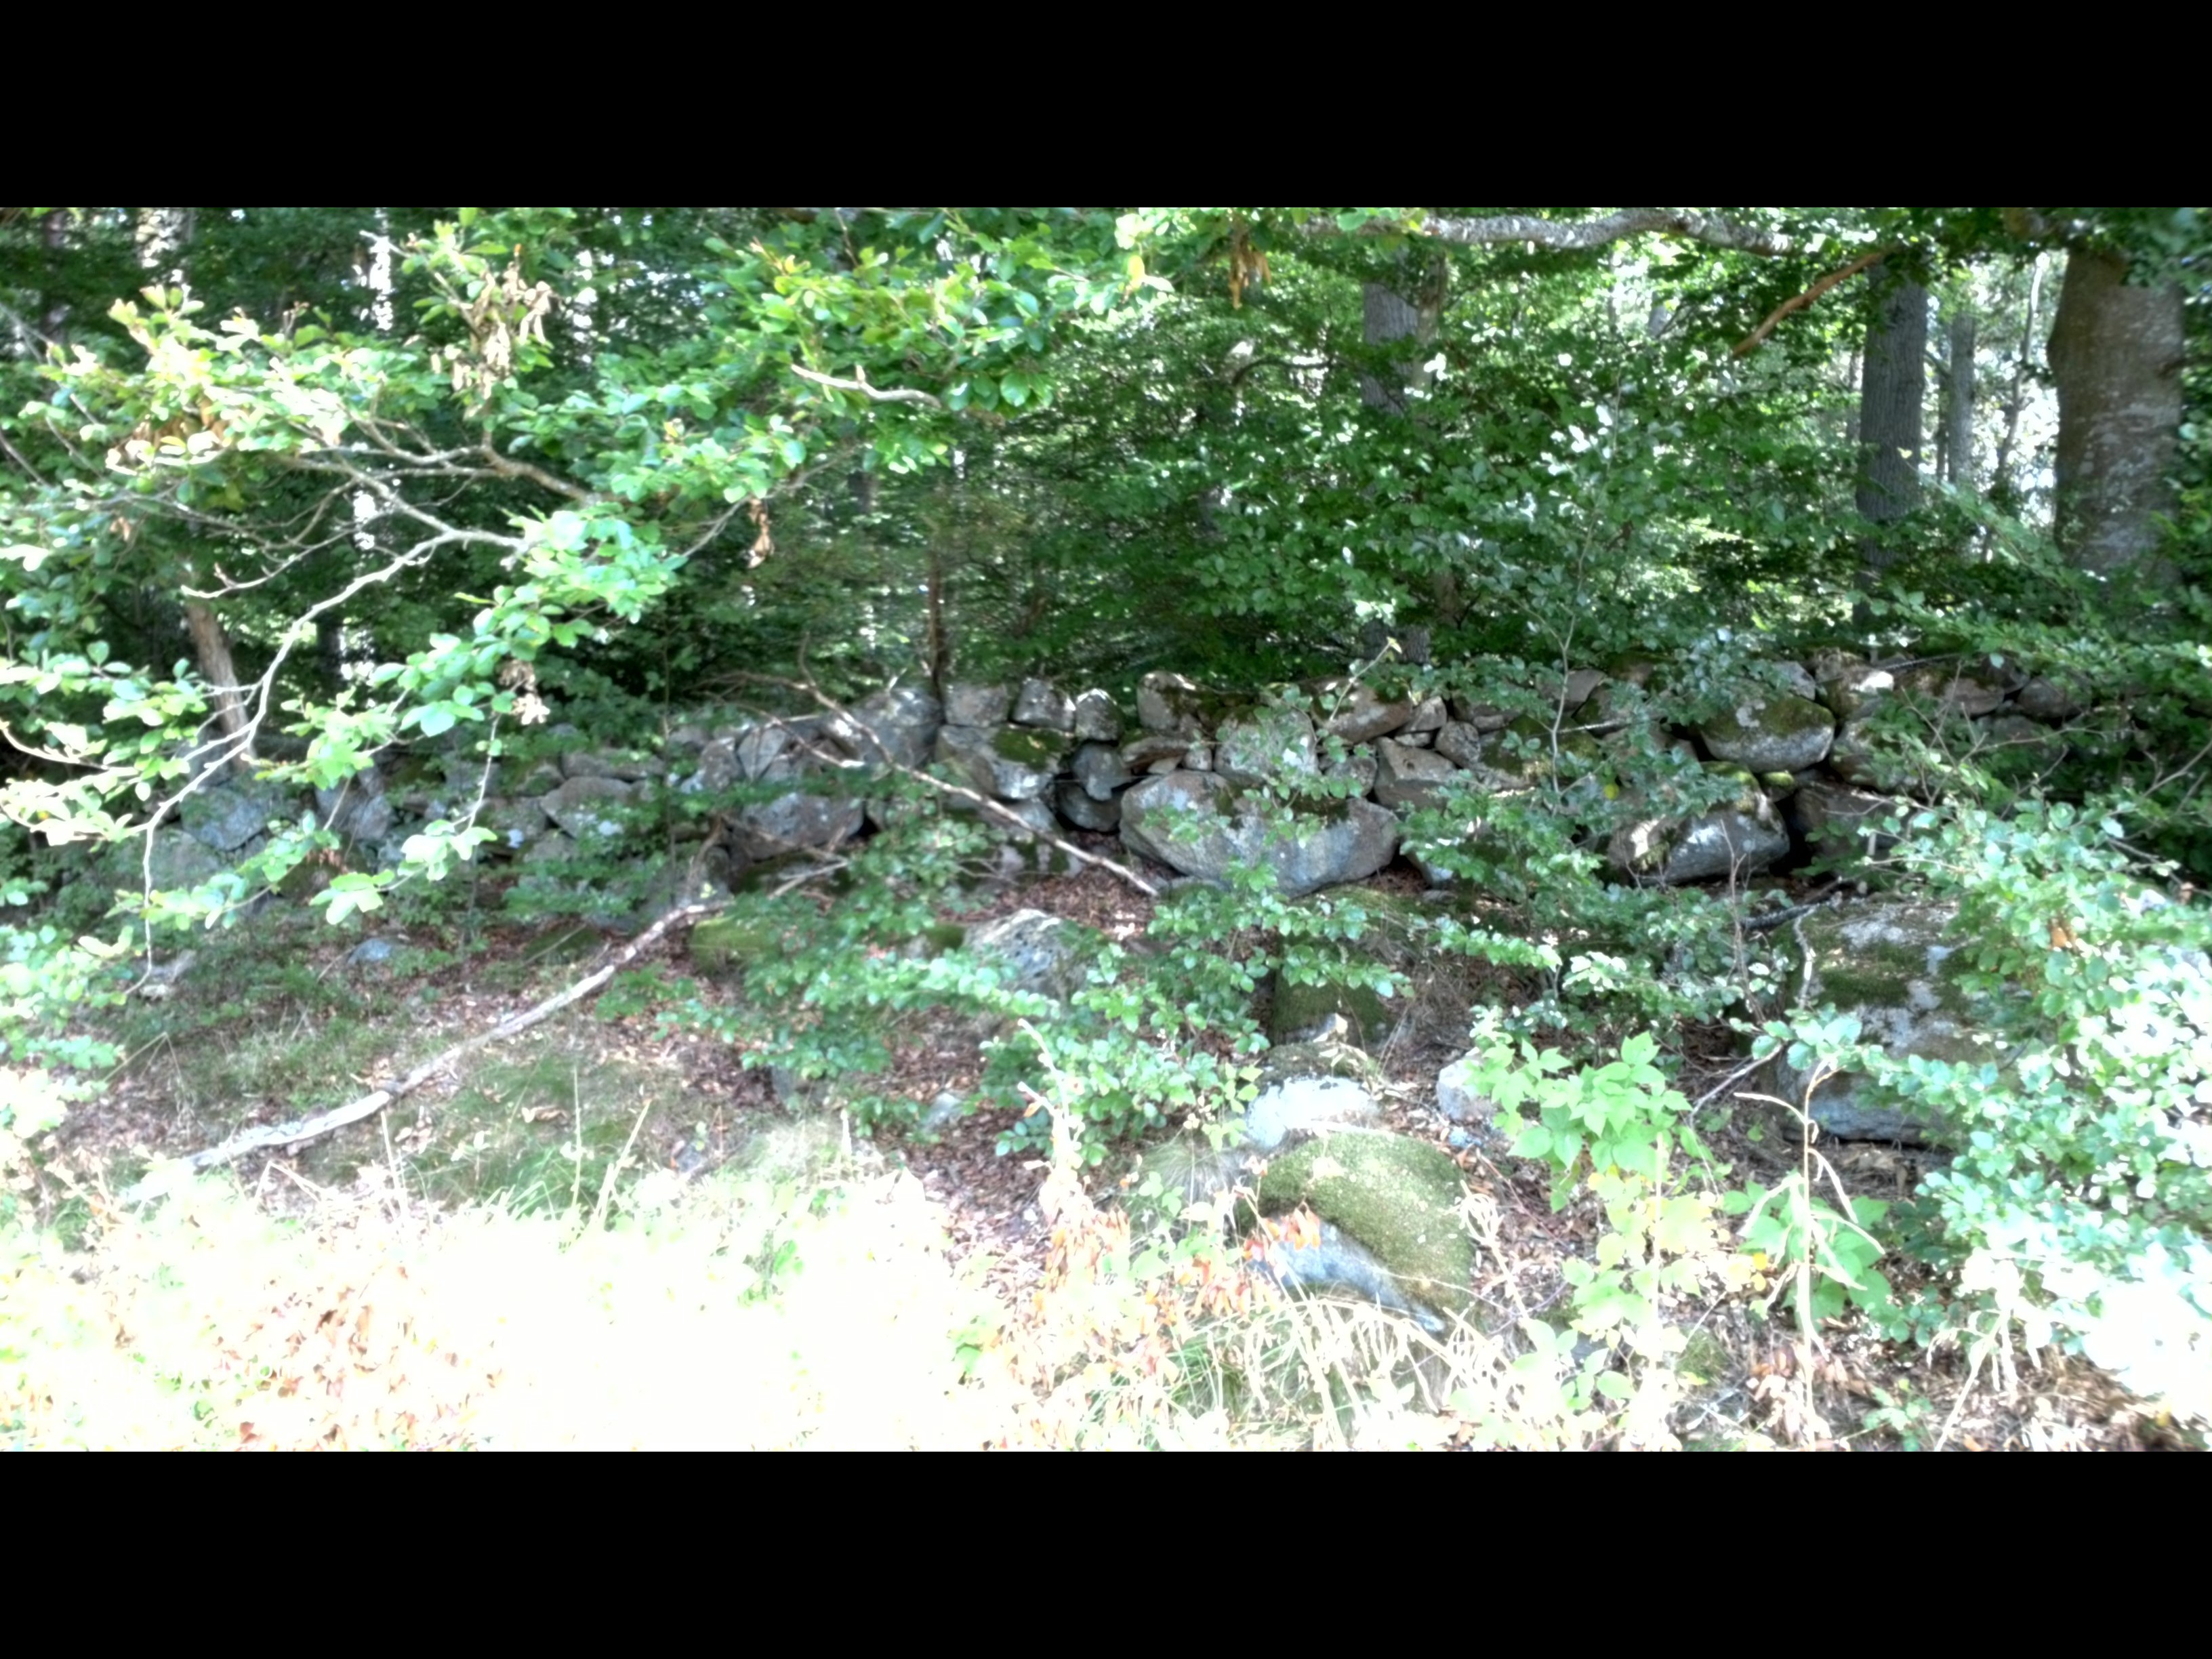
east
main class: Grassland
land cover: Grassland without tree/shrub cover
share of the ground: > 75 %
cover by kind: herbaceous plants 100 %
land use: Agriculture (excluding fallow land and kitchen gardens)
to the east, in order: Grassland without tree/shrub cover; Broadleaved woodland; Dry stone walls; Broadleaved woodland; Dry stone walls; Broadleaved woodland; Grassland without tree/shrub cover; Fences; Grassland without tree/shrub cover; Paved roads, cycling and walking lanes
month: August
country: SE
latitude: 56.1887
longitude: 14.7841
